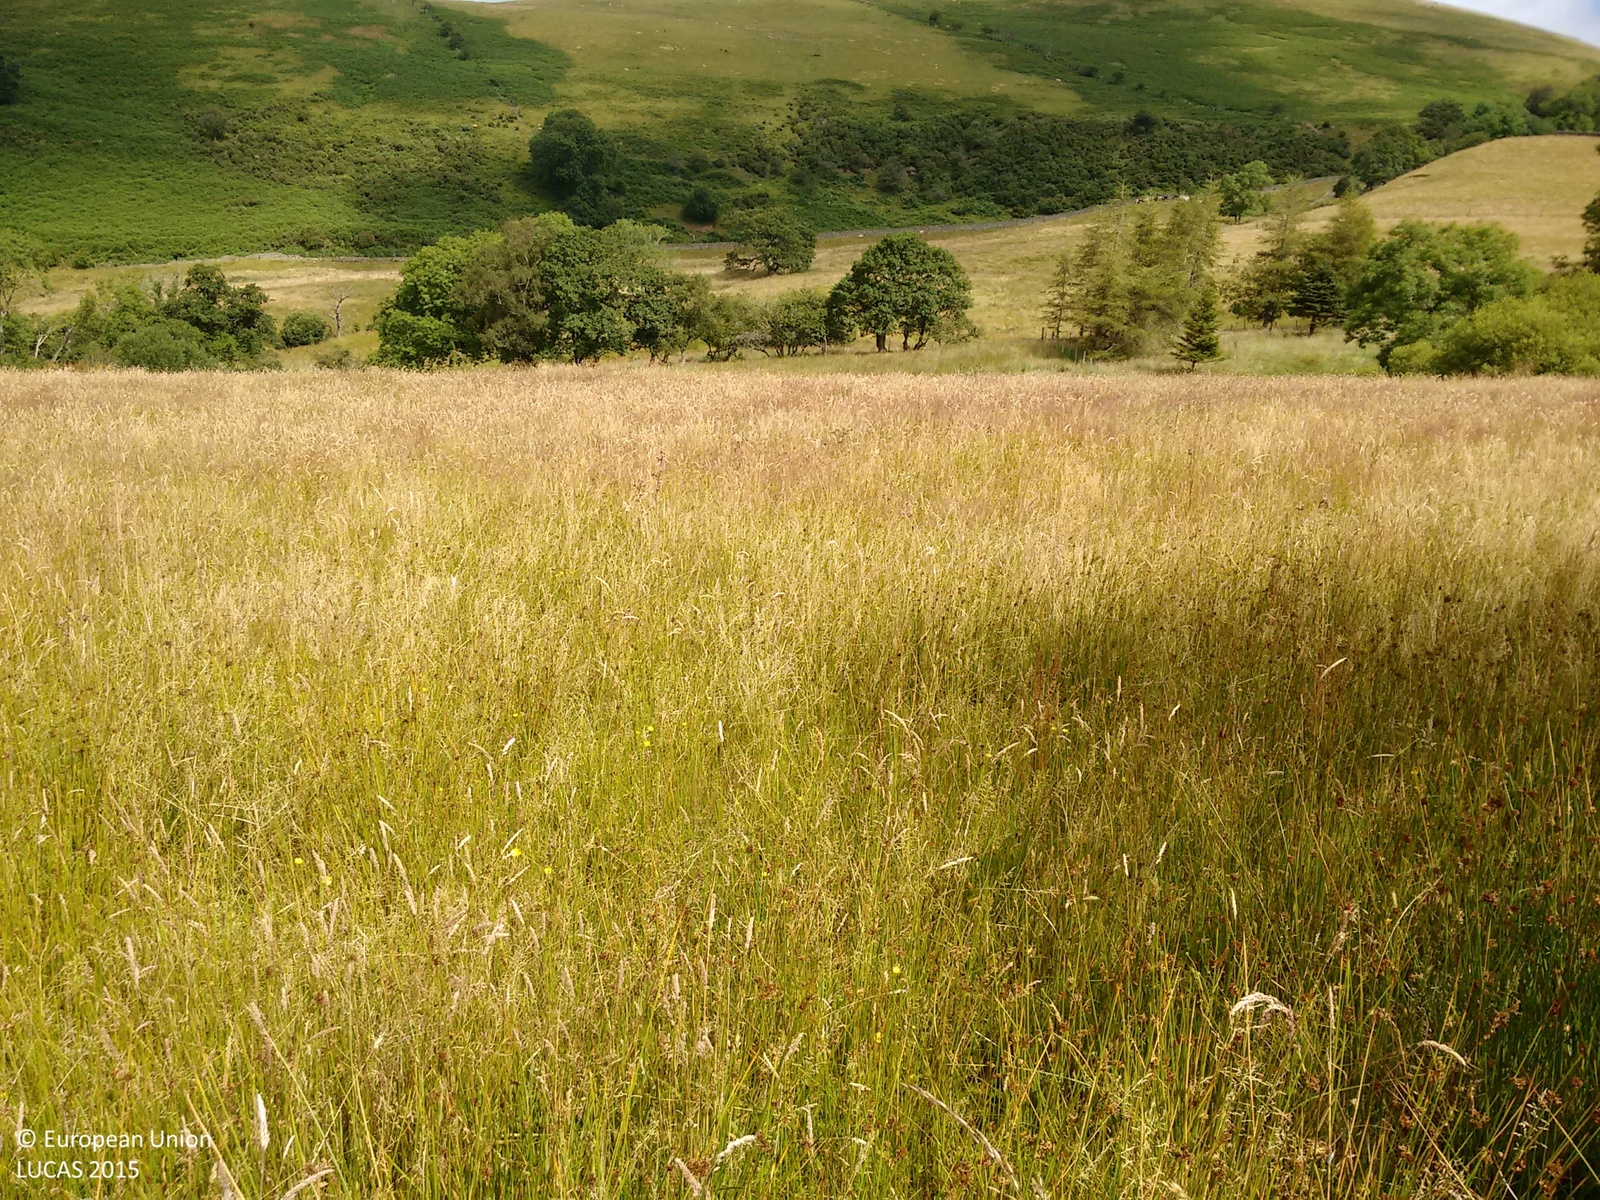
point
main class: Grassland
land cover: Grassland without tree/shrub cover
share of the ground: > 75 %
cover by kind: herbaceous plants 100 %
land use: Agriculture (excluding fallow land and kitchen gardens)
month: August
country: GB
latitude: 54.6030
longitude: -2.9037
